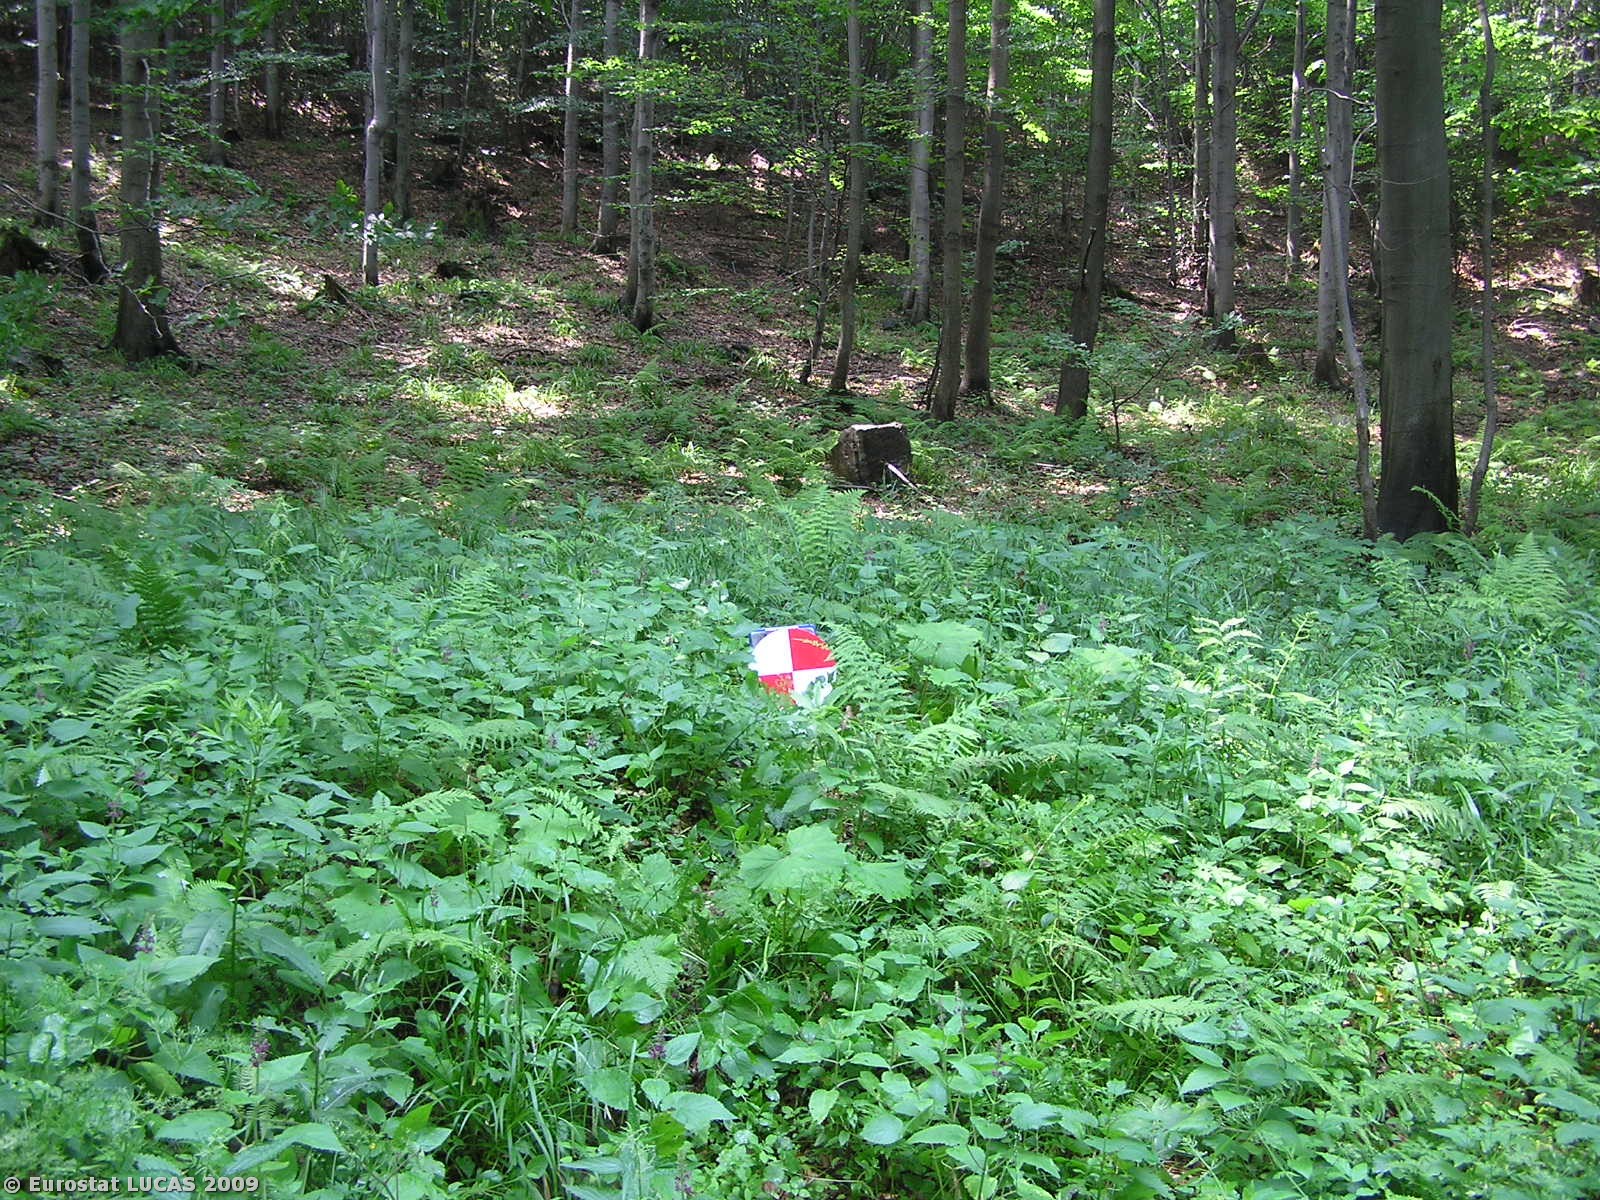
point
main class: Woodland
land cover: Broadleaved woodland
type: beech forest
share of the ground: > 75 %
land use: Forestry
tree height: > 5 m
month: July
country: CZ
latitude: 50.2415
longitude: 17.2604
